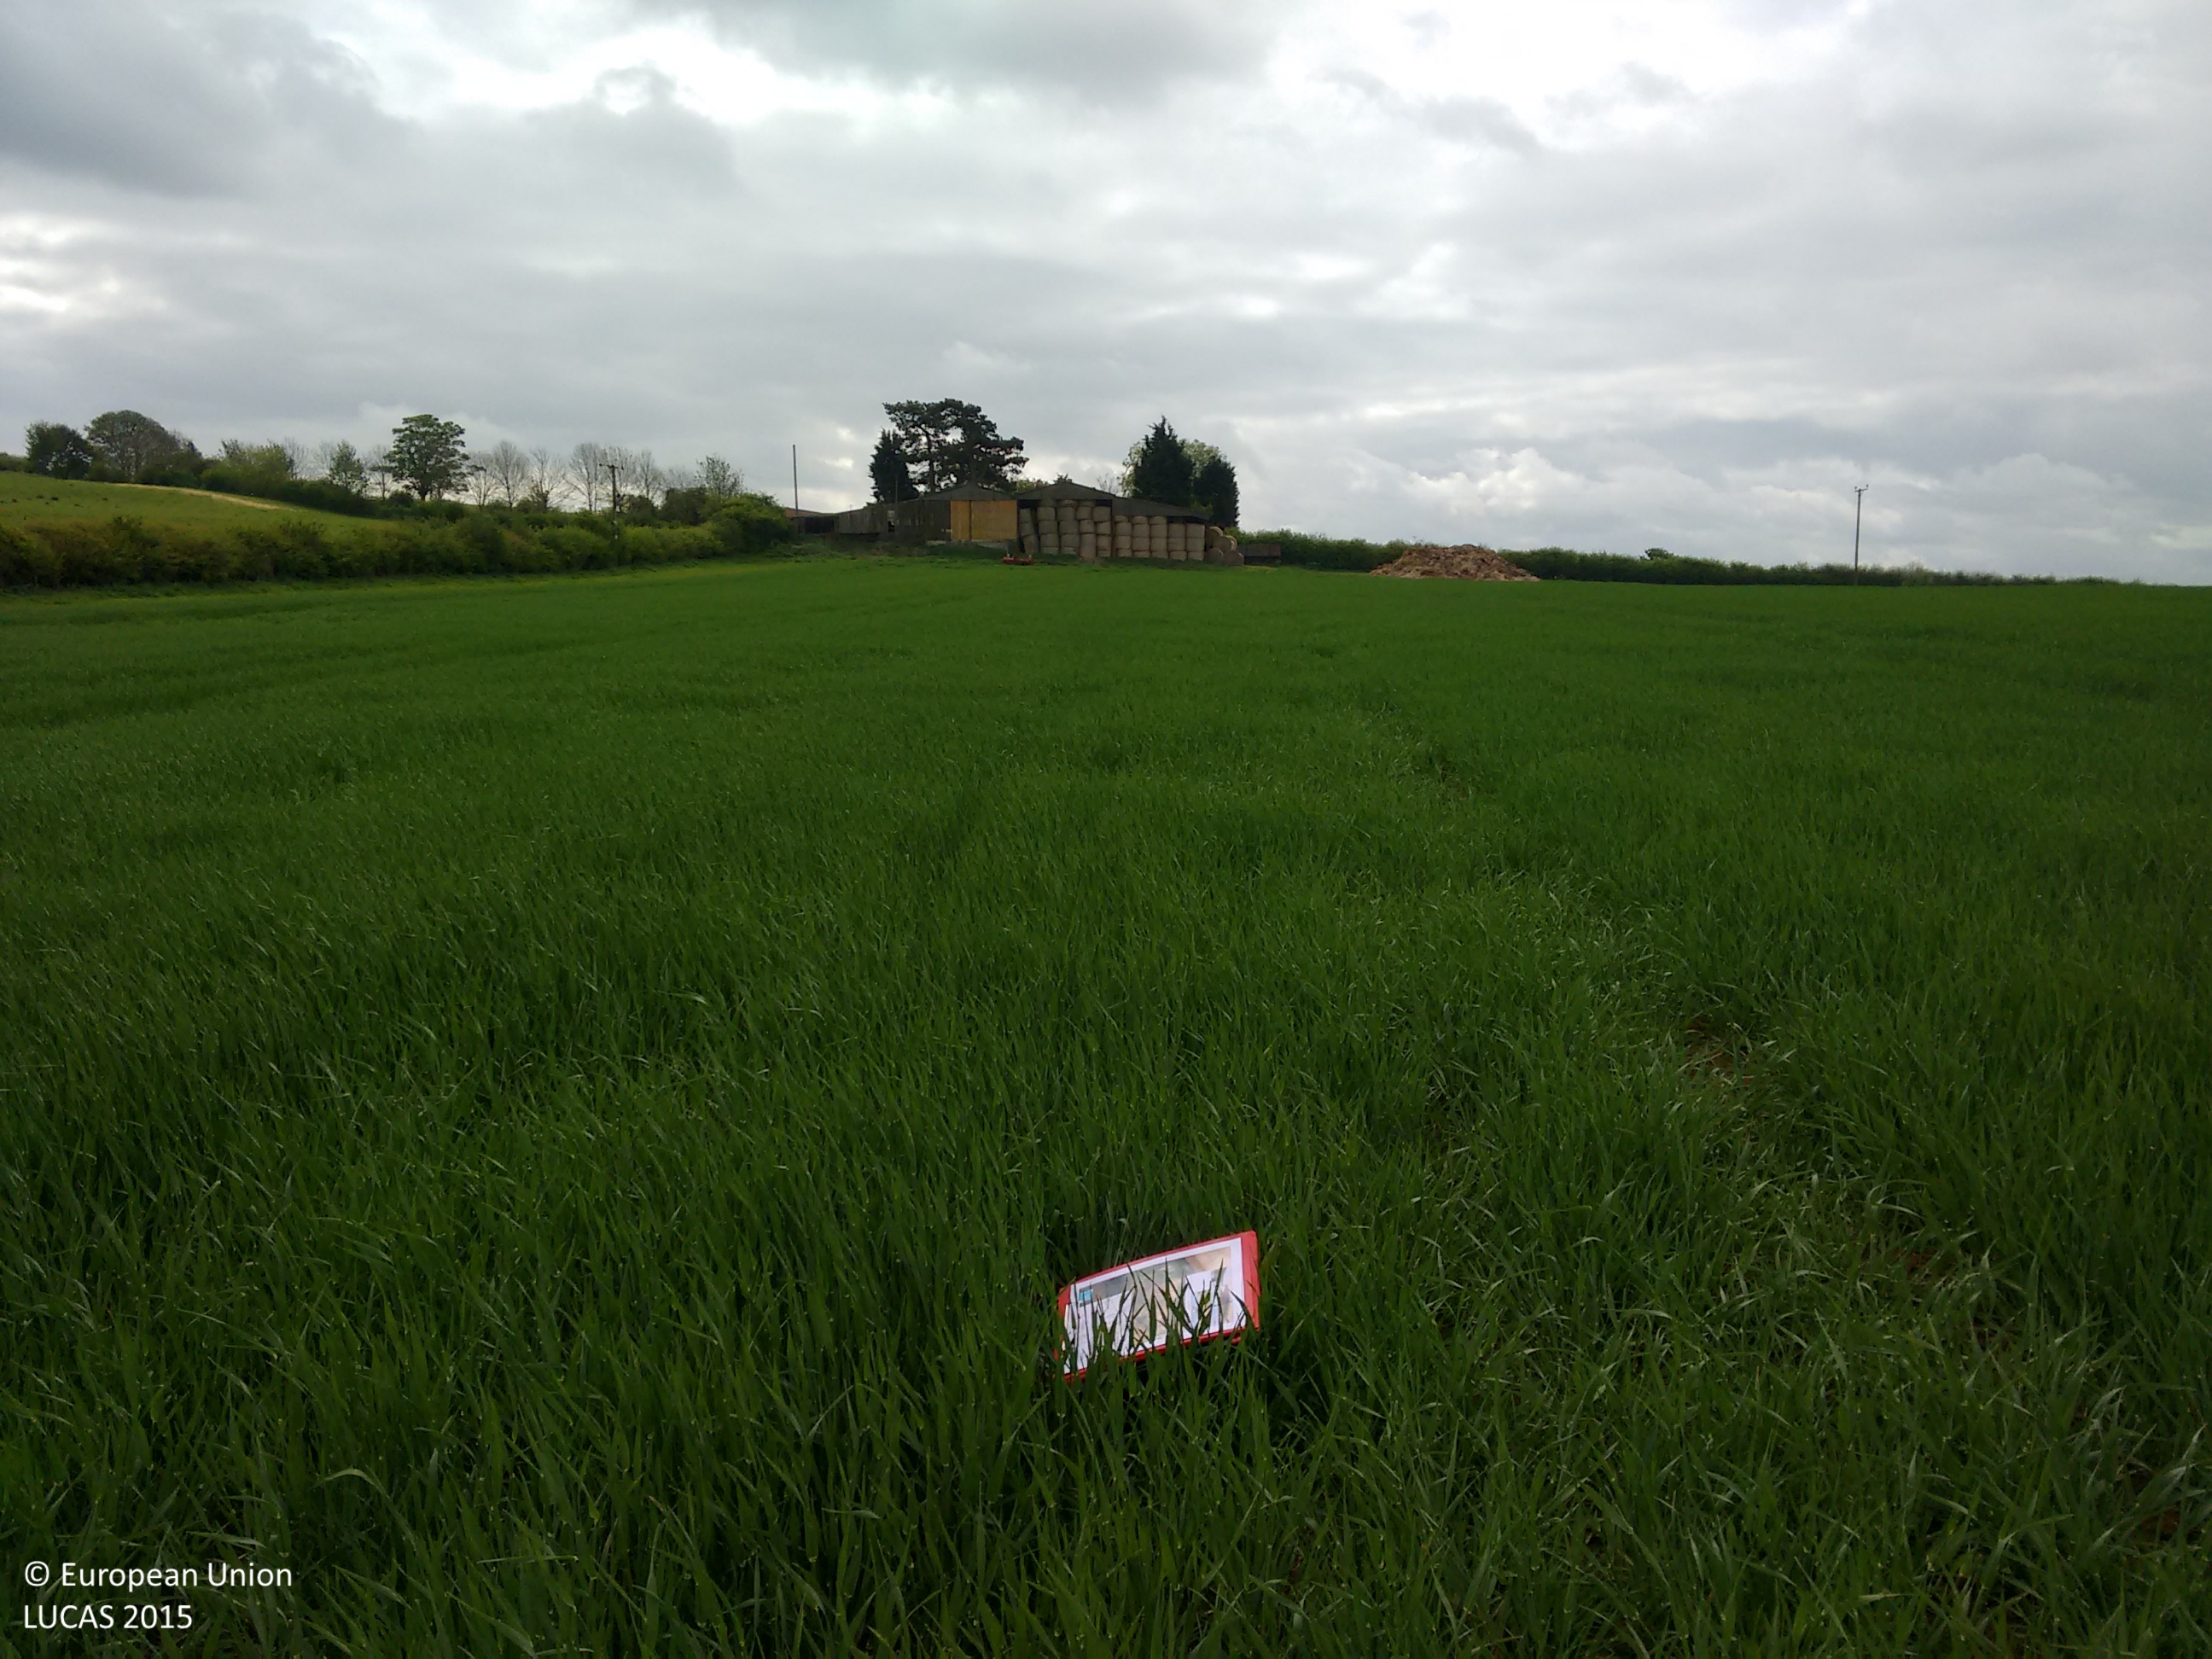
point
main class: Cropland
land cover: Barley
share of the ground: > 75 %
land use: Agriculture (excluding fallow land and kitchen gardens)
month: May
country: GB
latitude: 53.3377
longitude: -0.1406
